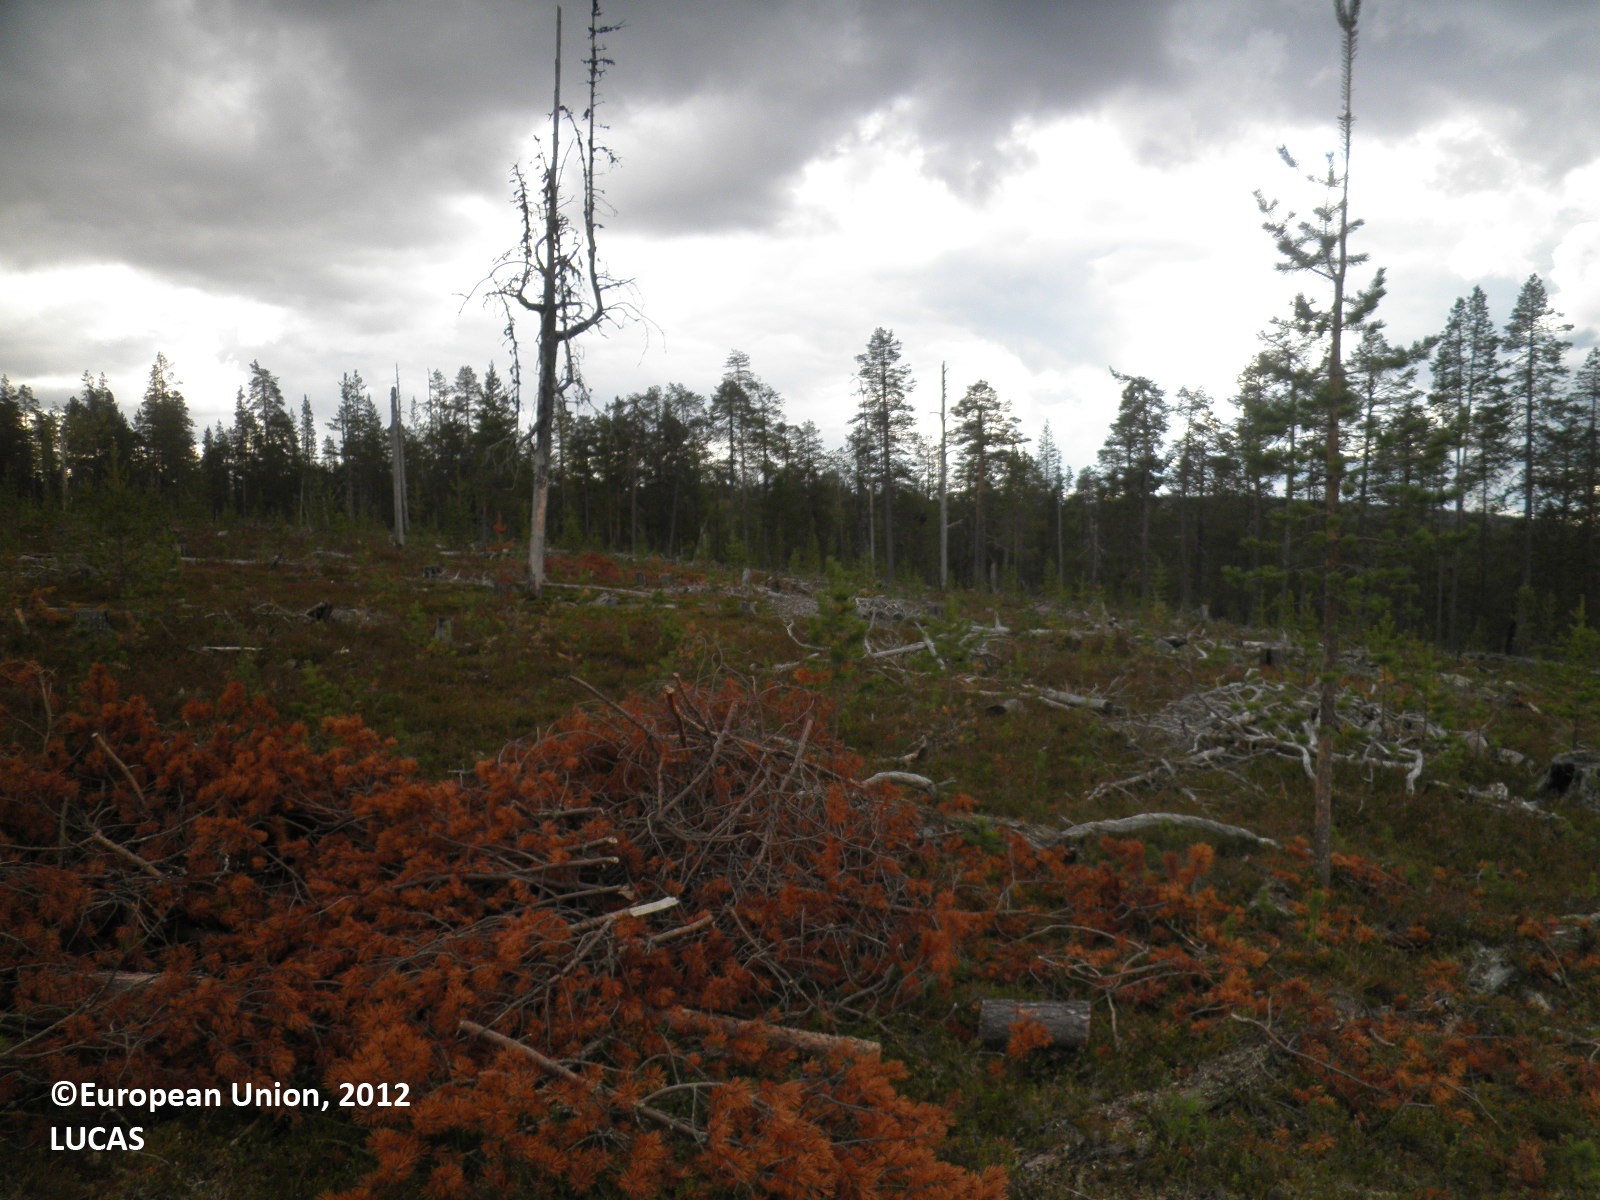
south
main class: Woodland
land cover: Pine dominated coniferous woodland
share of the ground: 10 - 25 %
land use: Forestry
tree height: < 5 m
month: August
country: FI
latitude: 67.9261
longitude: 28.2588
